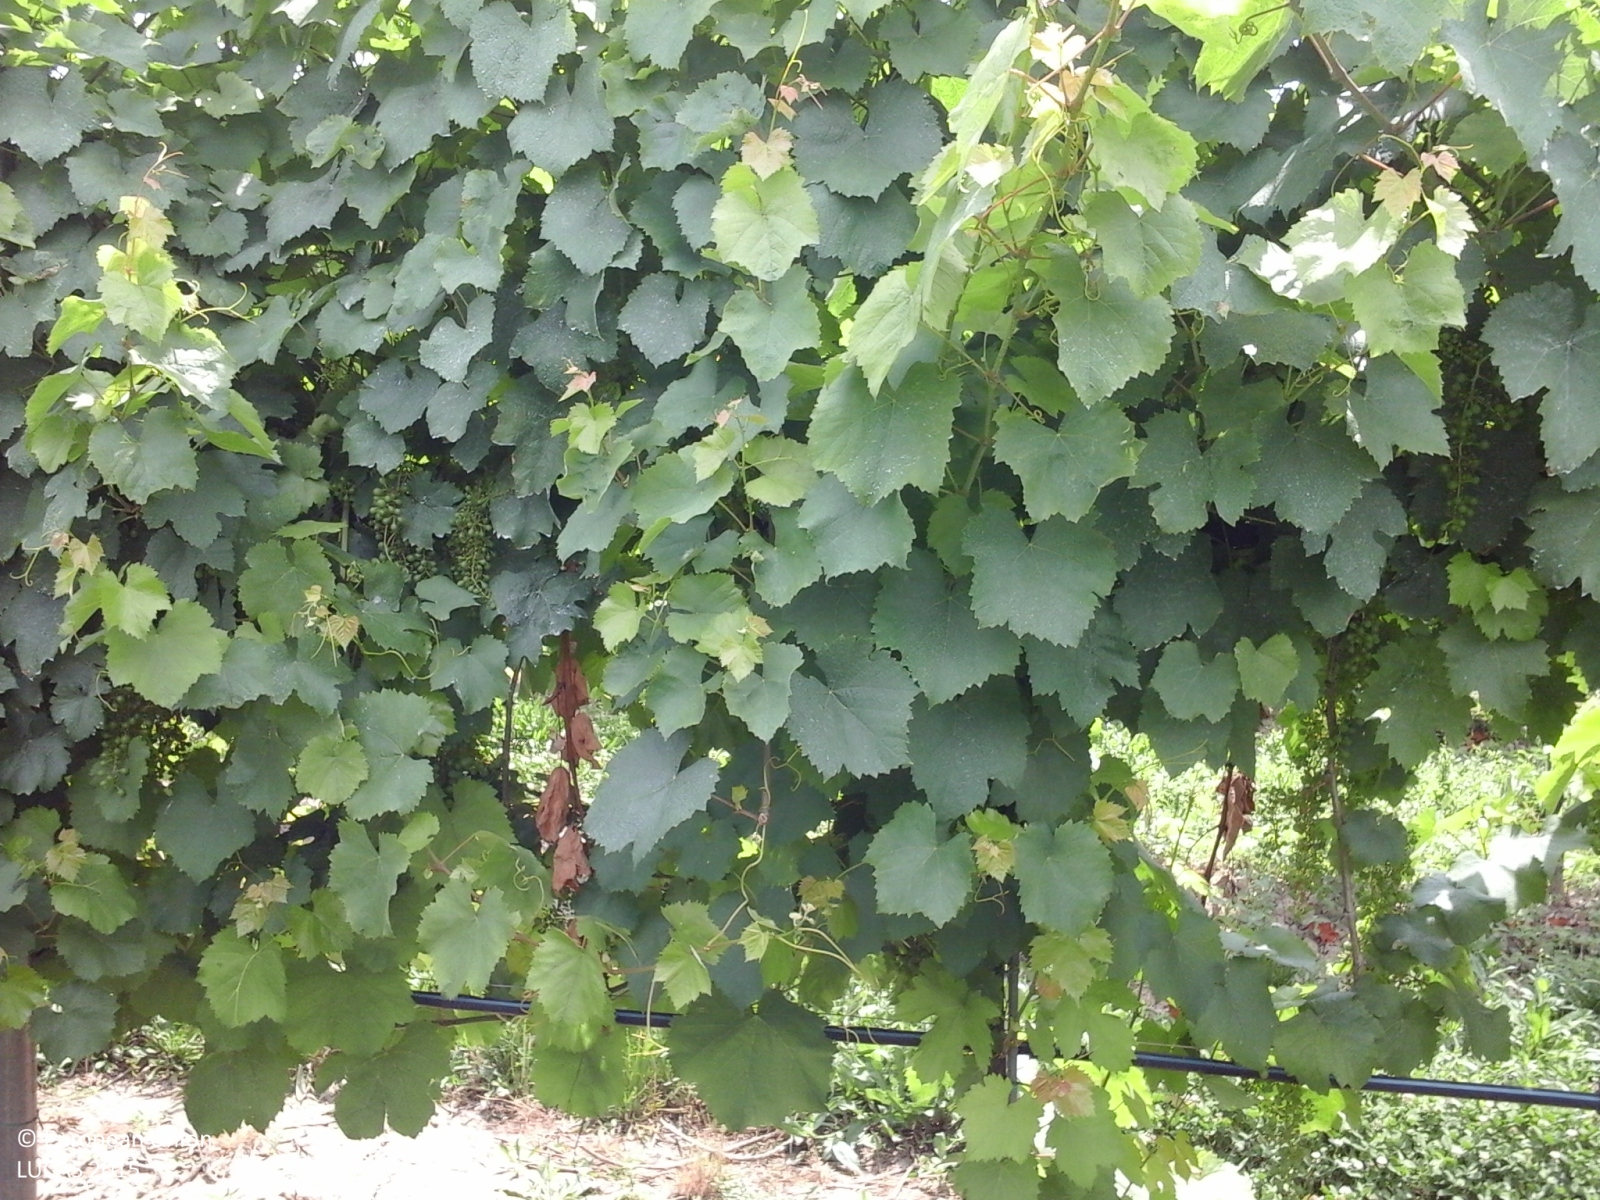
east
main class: Cropland
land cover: Vineyards
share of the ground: 50 - 75 %
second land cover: Grassland without tree/shrub cover
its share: > 75 %
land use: Agriculture (excluding fallow land and kitchen gardens)
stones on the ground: < 10 %
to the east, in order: Vineyards; Grassland without tree/shrub cover; Electric lines; Ditches and canals; Lucerne; Ditches and canals; Lucerne; Grass margins; Ditches and canals; Grass margins; Lucerne; Ditches and canals; Lucerne; Ditches and canals; Lucerne; Ditches and canals
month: June
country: IT
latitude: 44.6519
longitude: 11.0444
